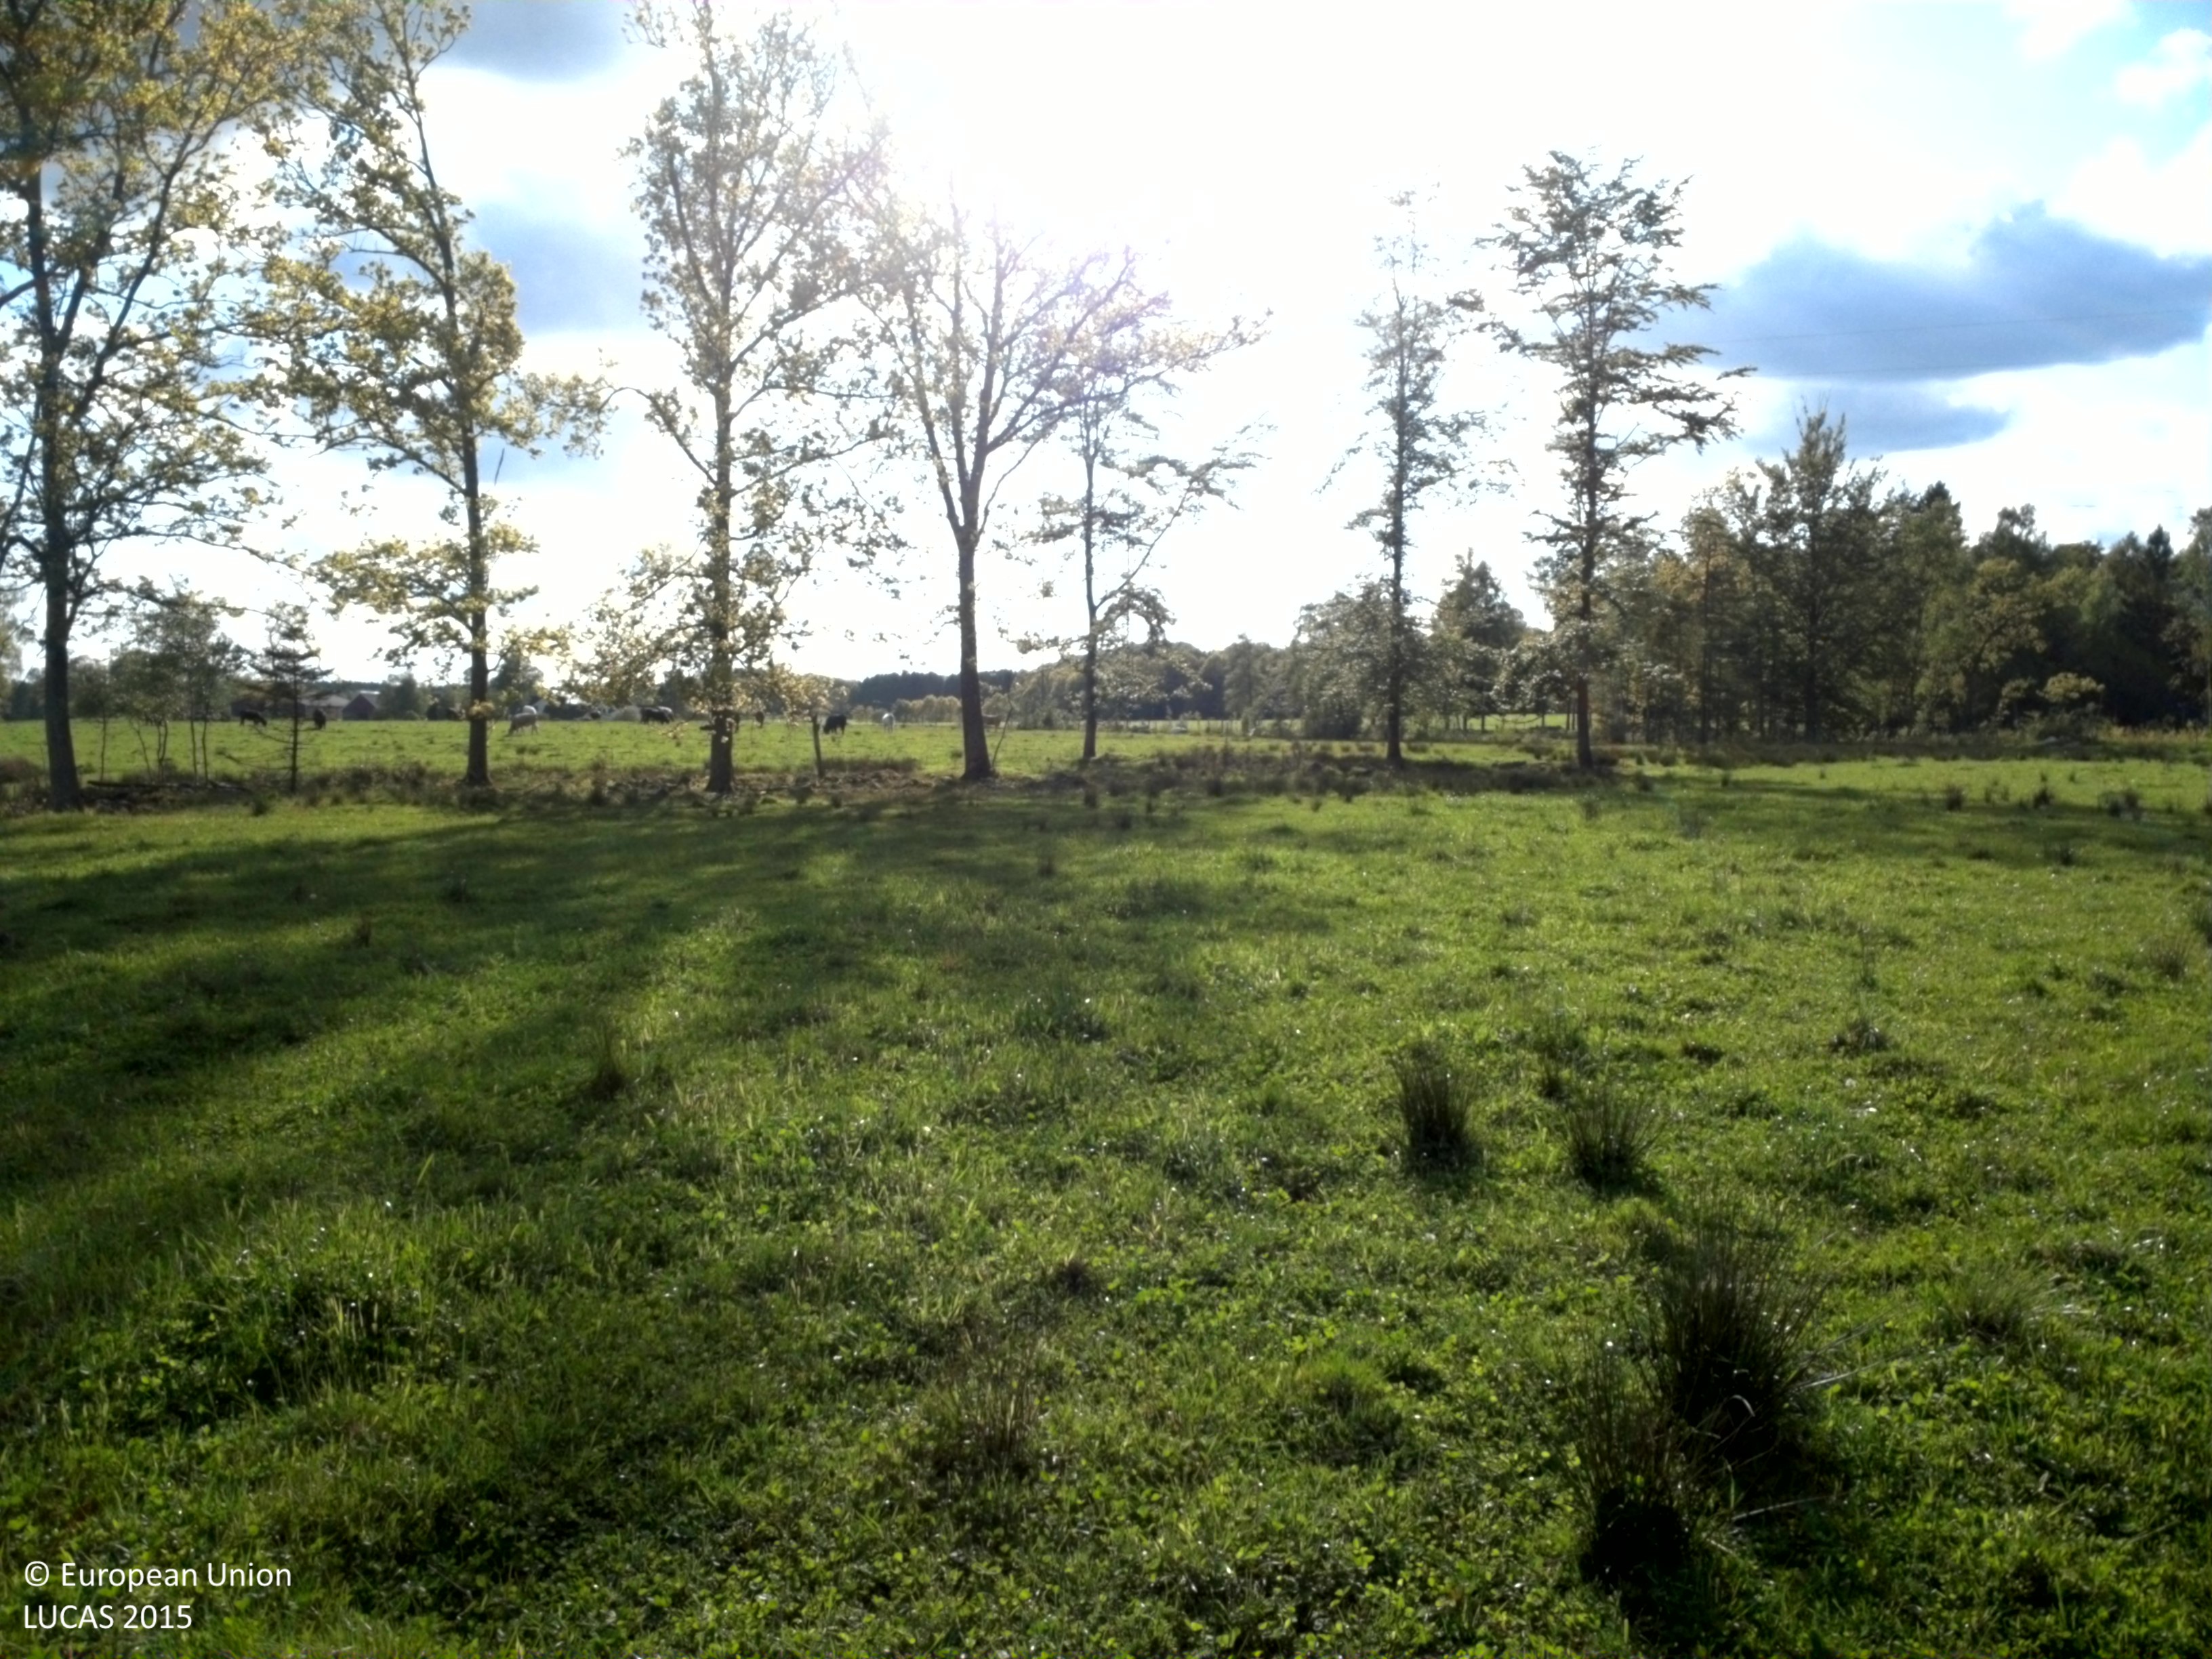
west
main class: Grassland
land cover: Grassland without tree/shrub cover
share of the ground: > 75 %
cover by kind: herbaceous plants 100 %
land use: Agriculture (excluding fallow land and kitchen gardens)
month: June
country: SE
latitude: 55.8998
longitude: 13.7243
